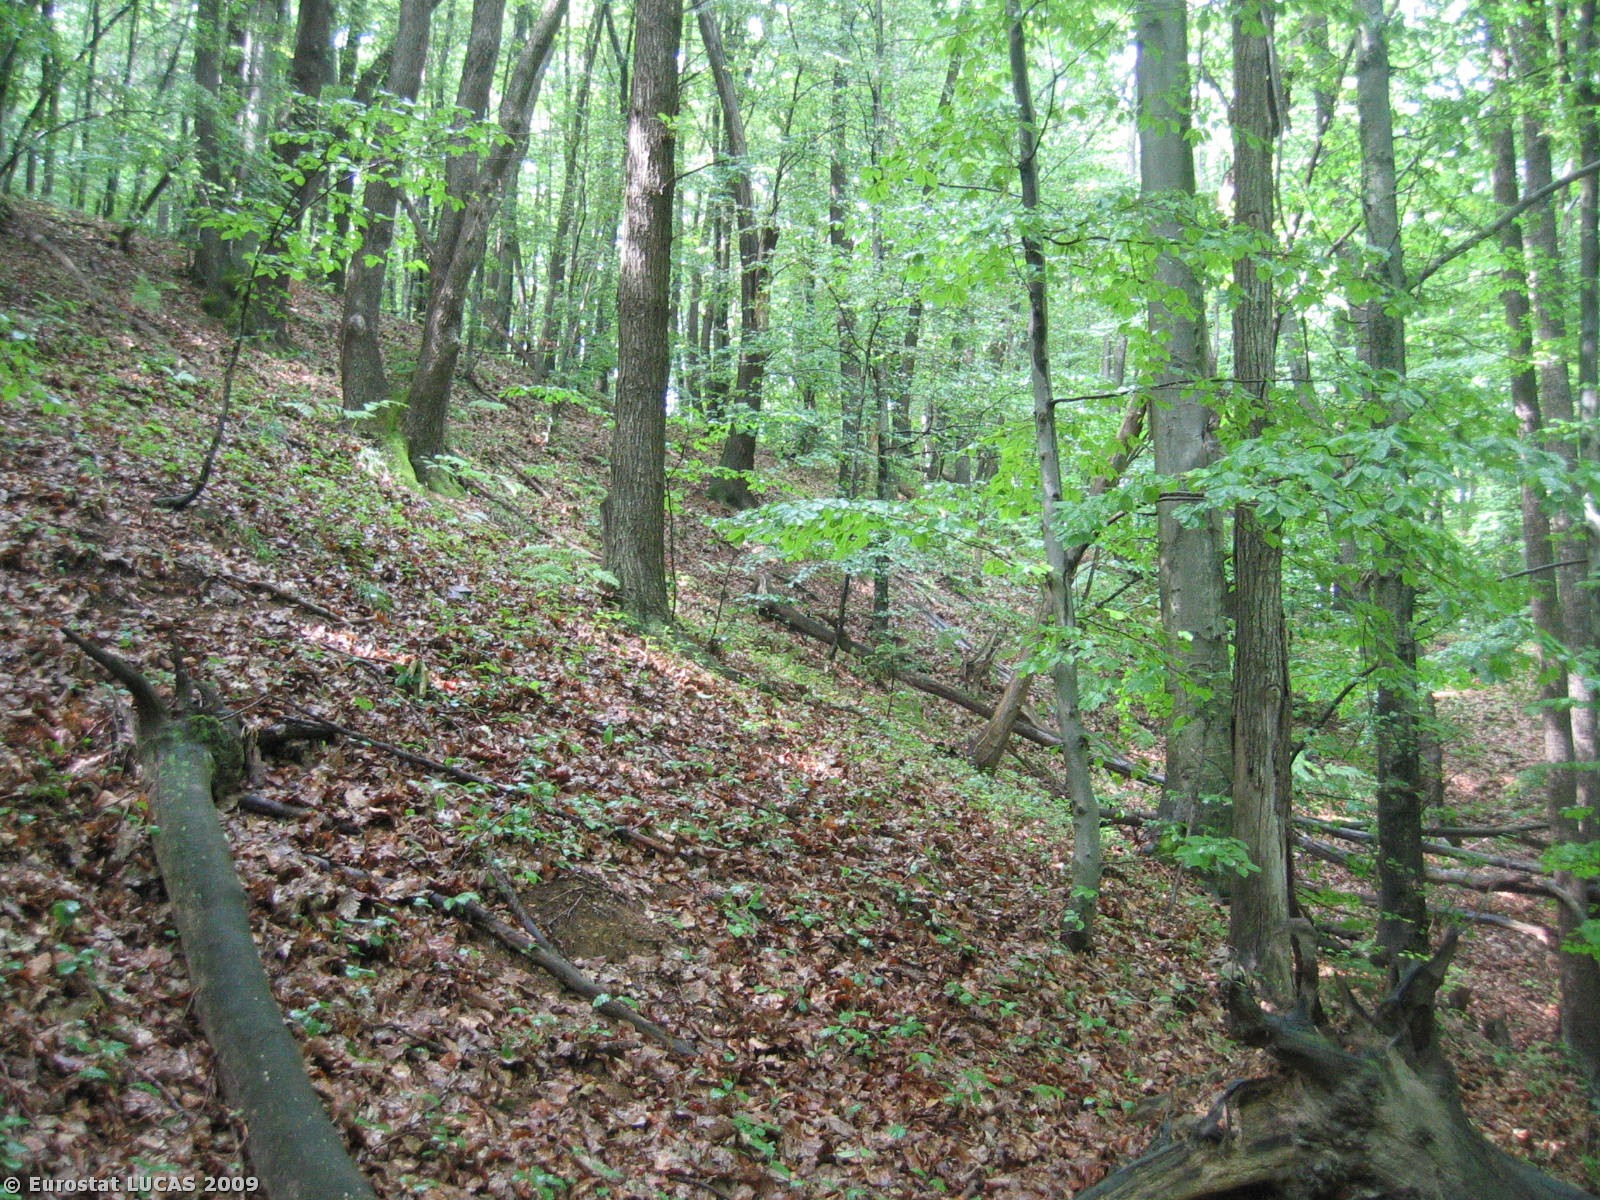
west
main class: Woodland
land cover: Mixed woodland
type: hemiboreal forest and nemoral coniferous forest and mixed broadleaved-coniferous forest
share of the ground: > 75 %
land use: Forestry
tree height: > 5 m
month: July
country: SI
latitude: 46.0103
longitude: 14.3486
